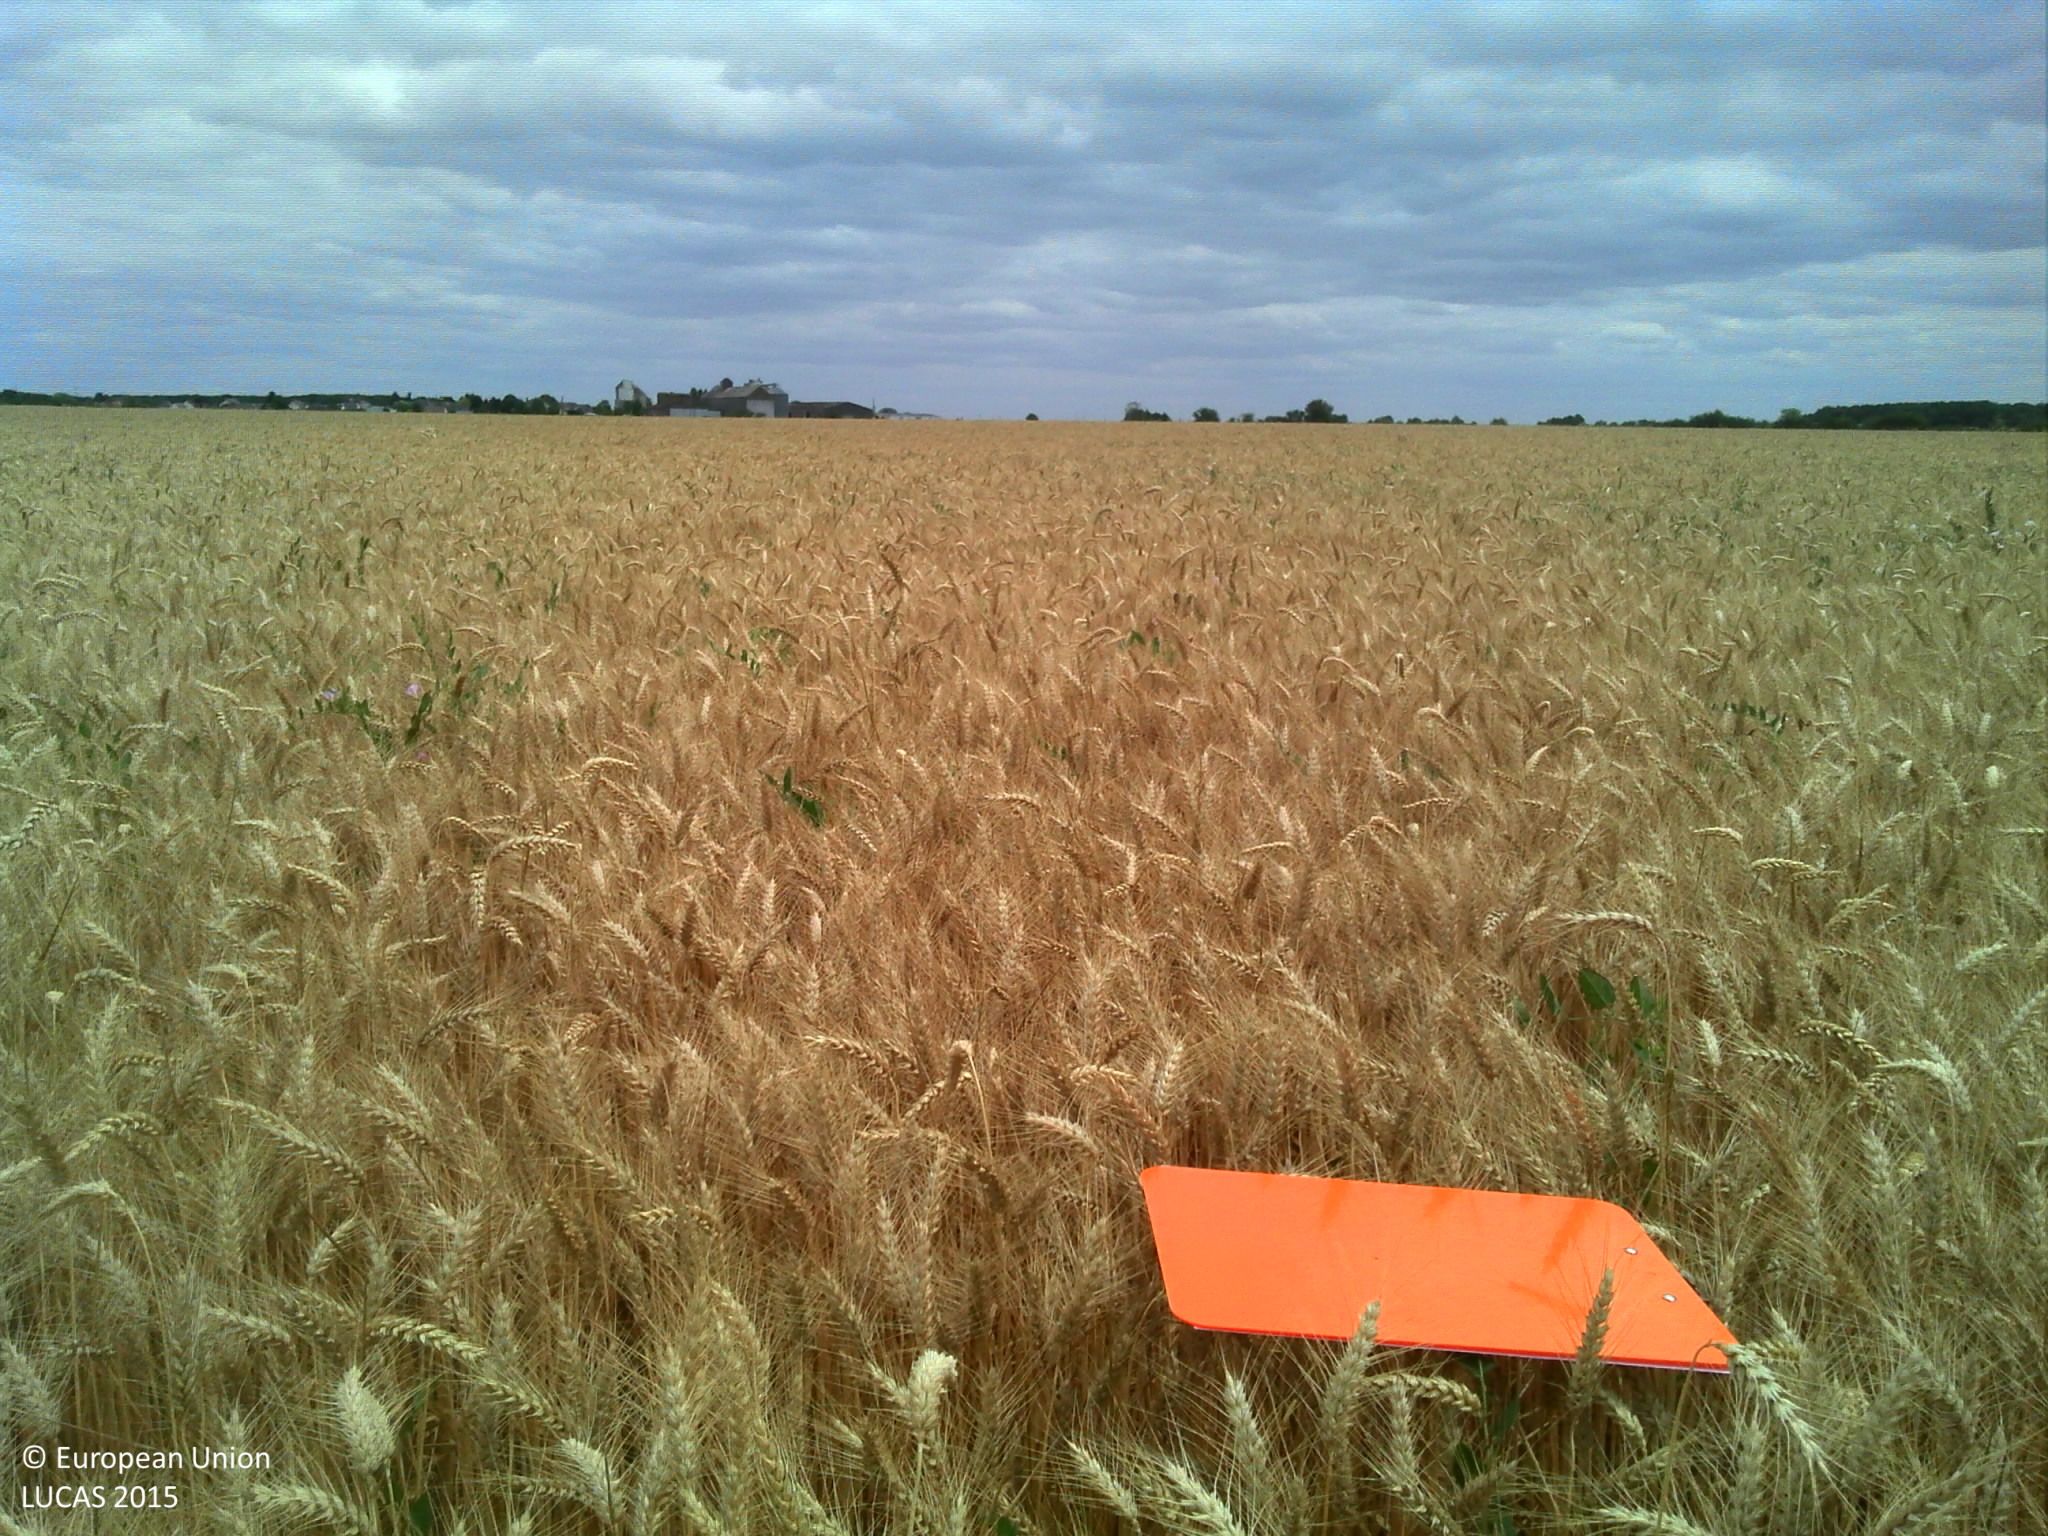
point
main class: Cropland
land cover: Common wheat
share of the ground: > 75 %
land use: Agriculture (excluding fallow land and kitchen gardens)
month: July
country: FR
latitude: 47.3070
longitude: 0.5222
